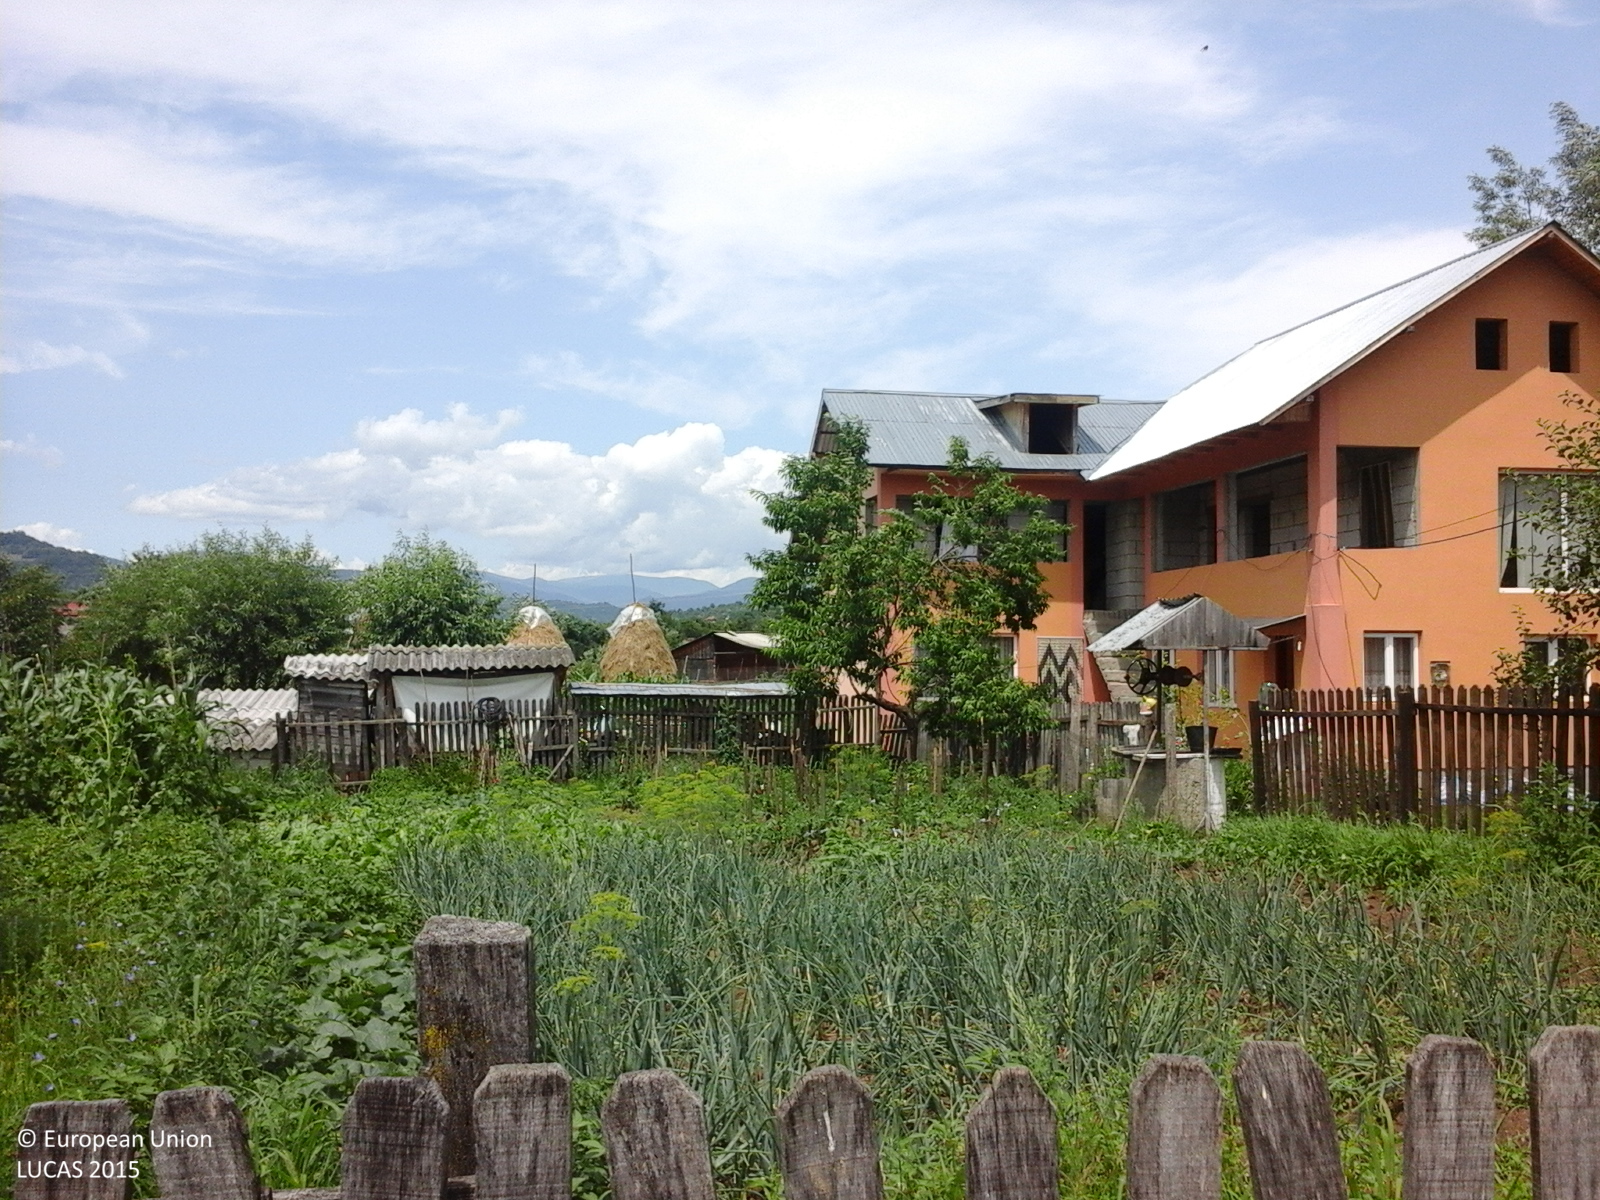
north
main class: Cropland
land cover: Potatoes
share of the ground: > 75 %
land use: Kitchen garden
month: July
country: RO
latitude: 45.2769
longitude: 24.8072
